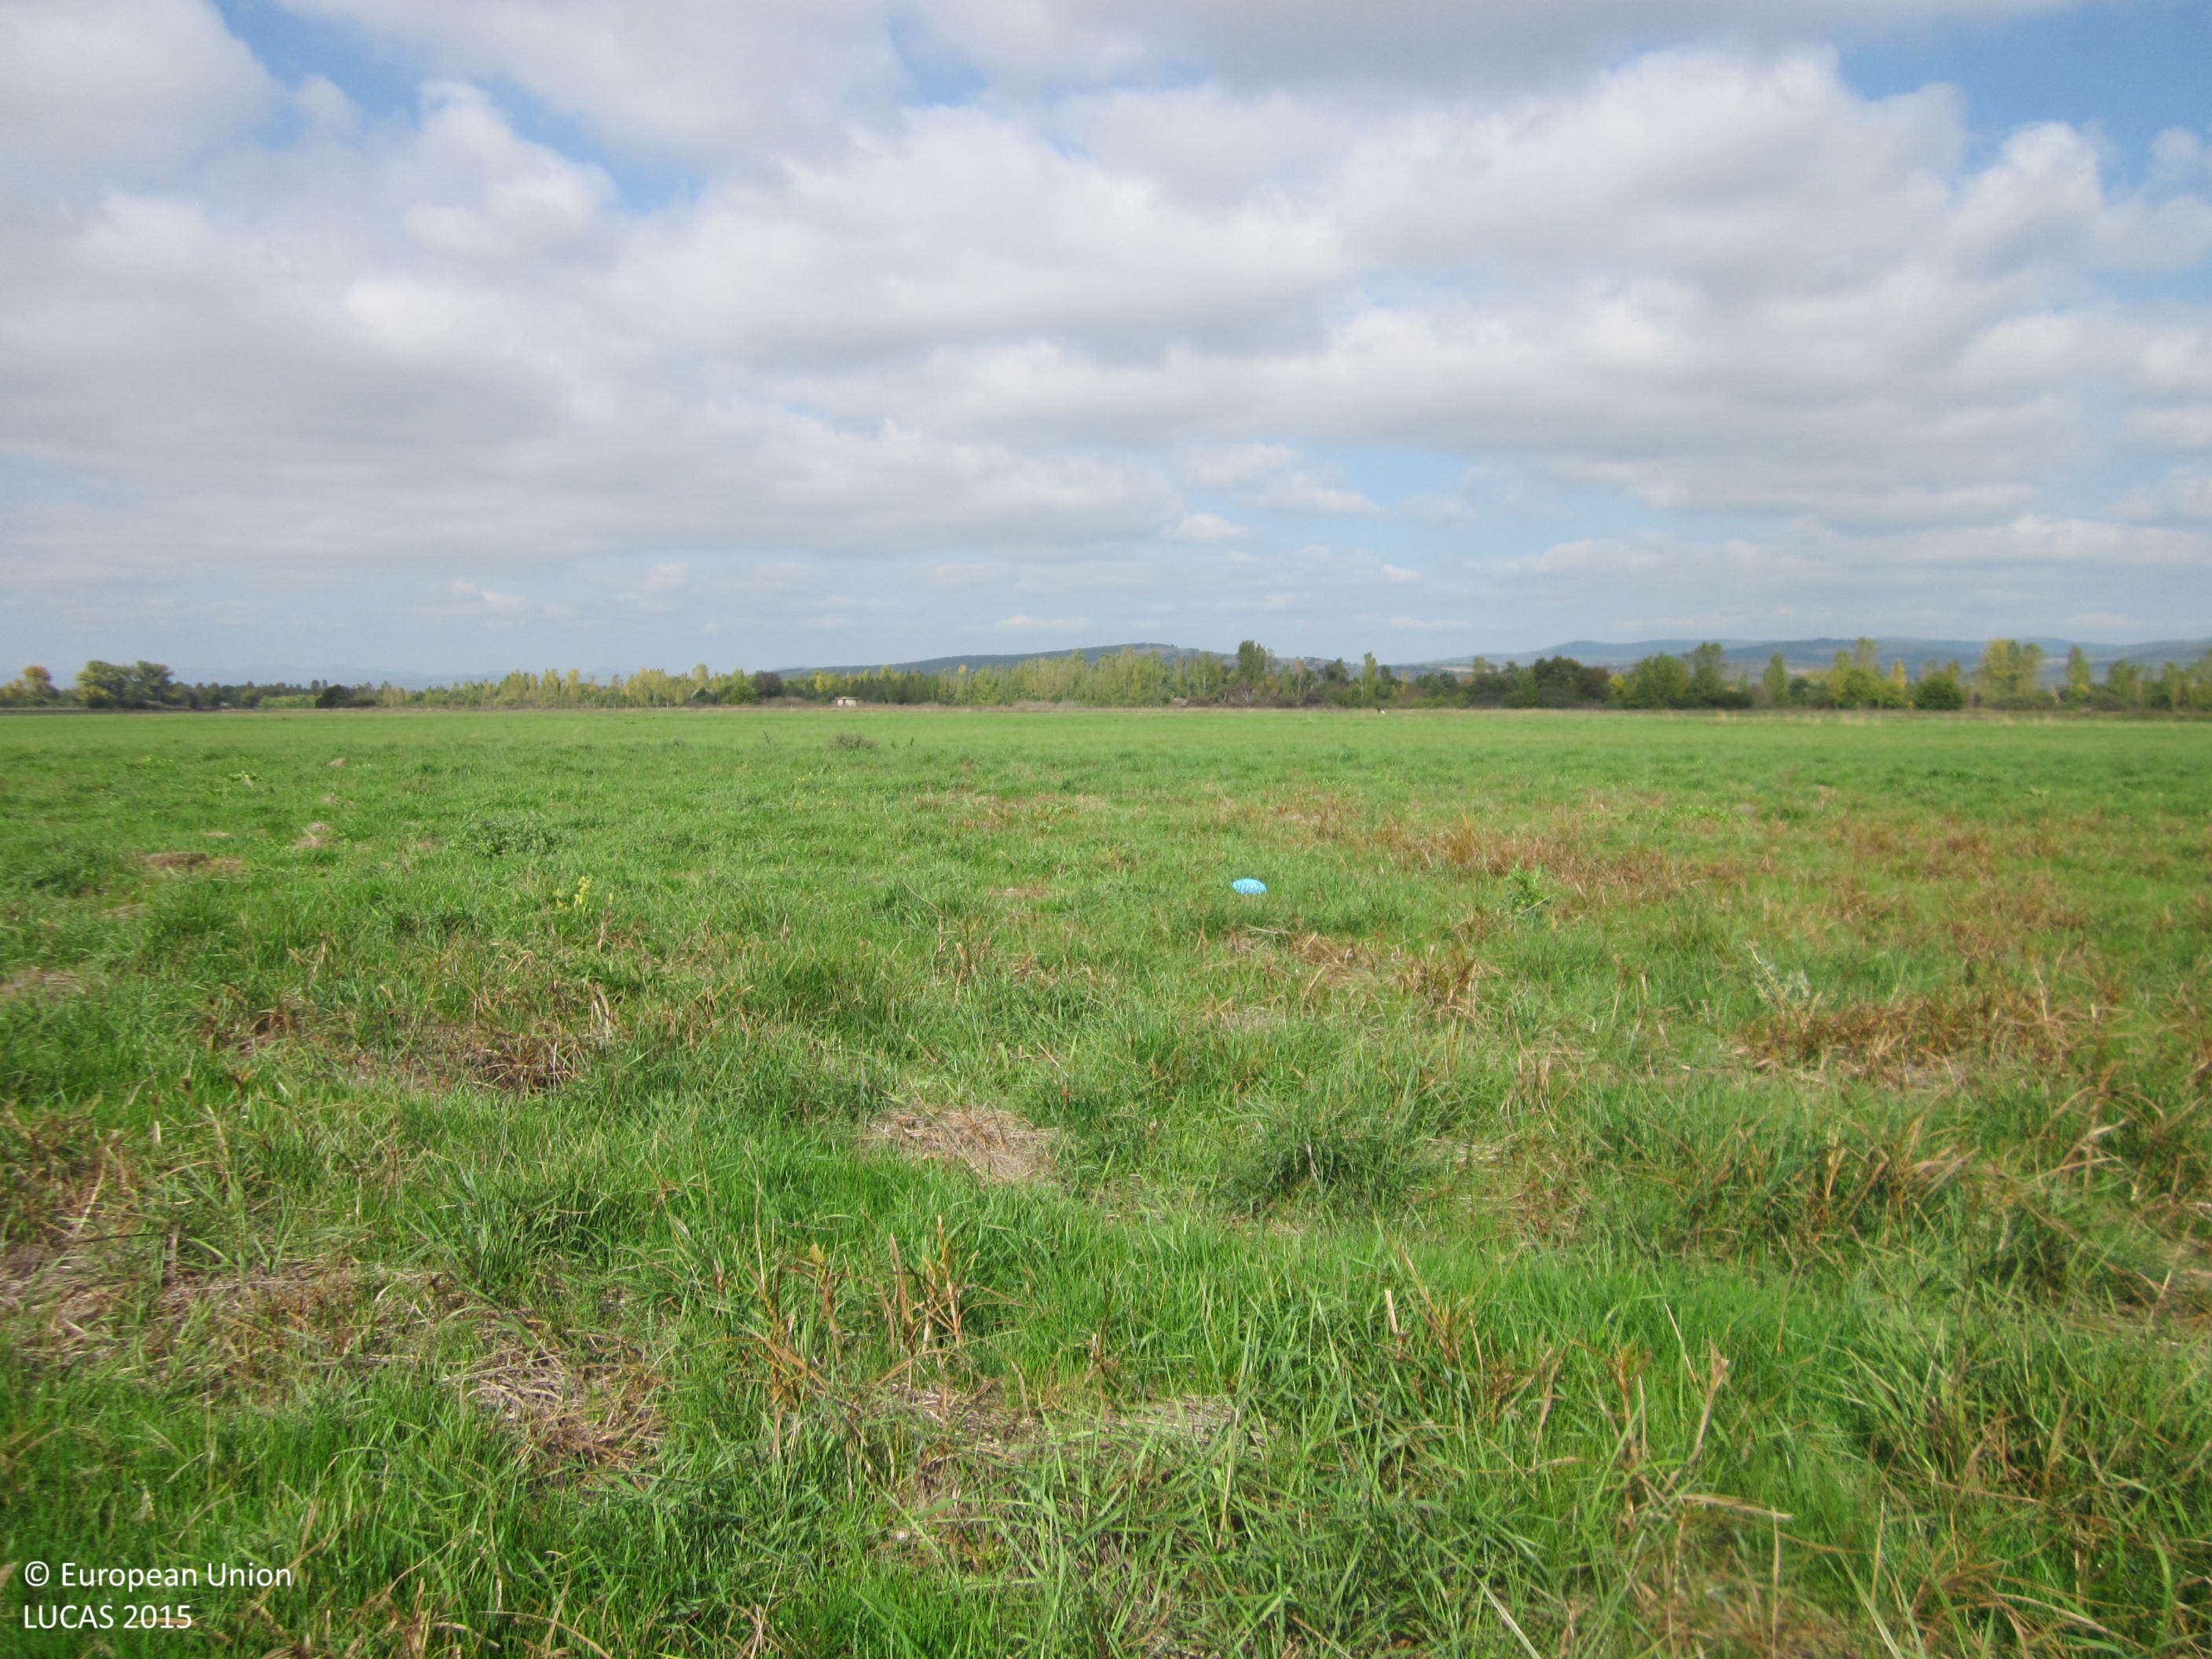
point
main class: Grassland
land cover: Grassland without tree/shrub cover
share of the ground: > 75 %
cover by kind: herbaceous plants 100 %
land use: Agriculture (excluding fallow land and kitchen gardens)
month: October
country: BG
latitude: 42.6964
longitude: 26.8888
